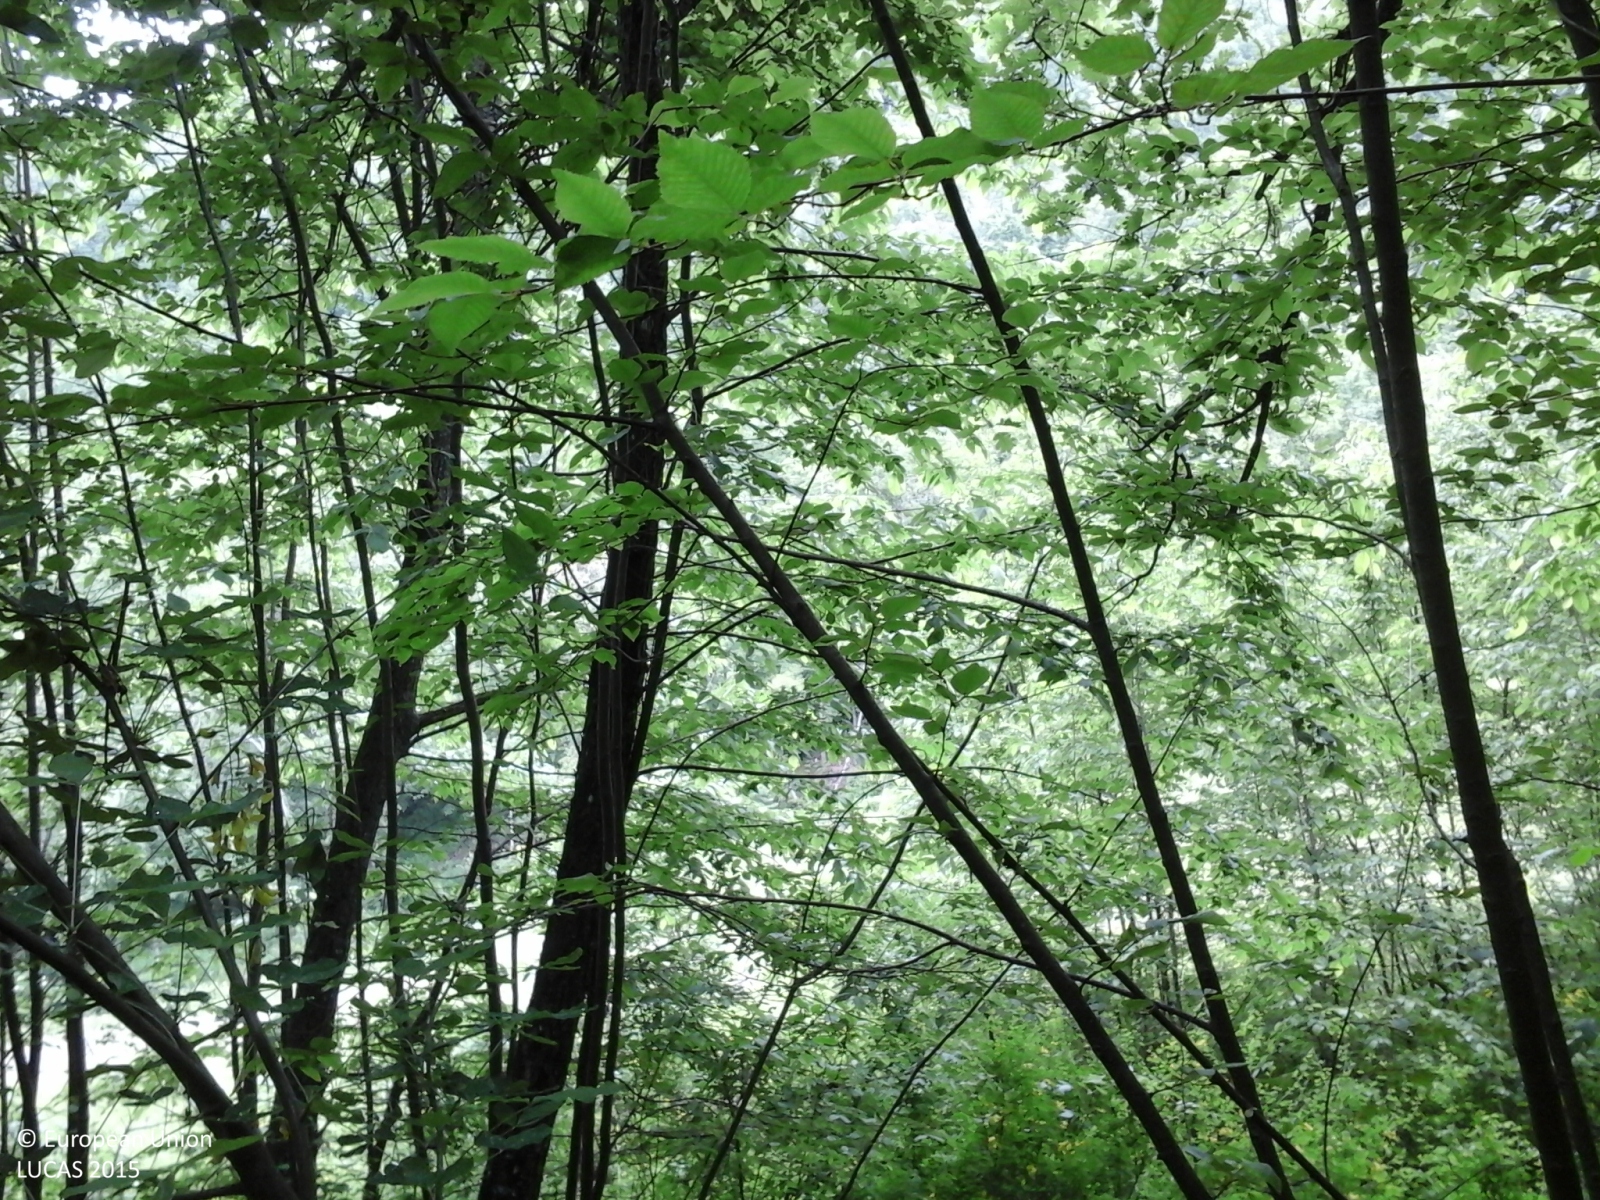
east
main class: Woodland
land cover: Broadleaved woodland
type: thermophilous deciduous forest
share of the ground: > 75 %
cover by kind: broadleaved forest trees 80 %, shrubs 20 %
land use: Forestry
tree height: > 5 m
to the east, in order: Broadleaved woodland; Grassland without tree/shrub cover
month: May
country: IT
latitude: 44.5849
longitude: 10.1634
